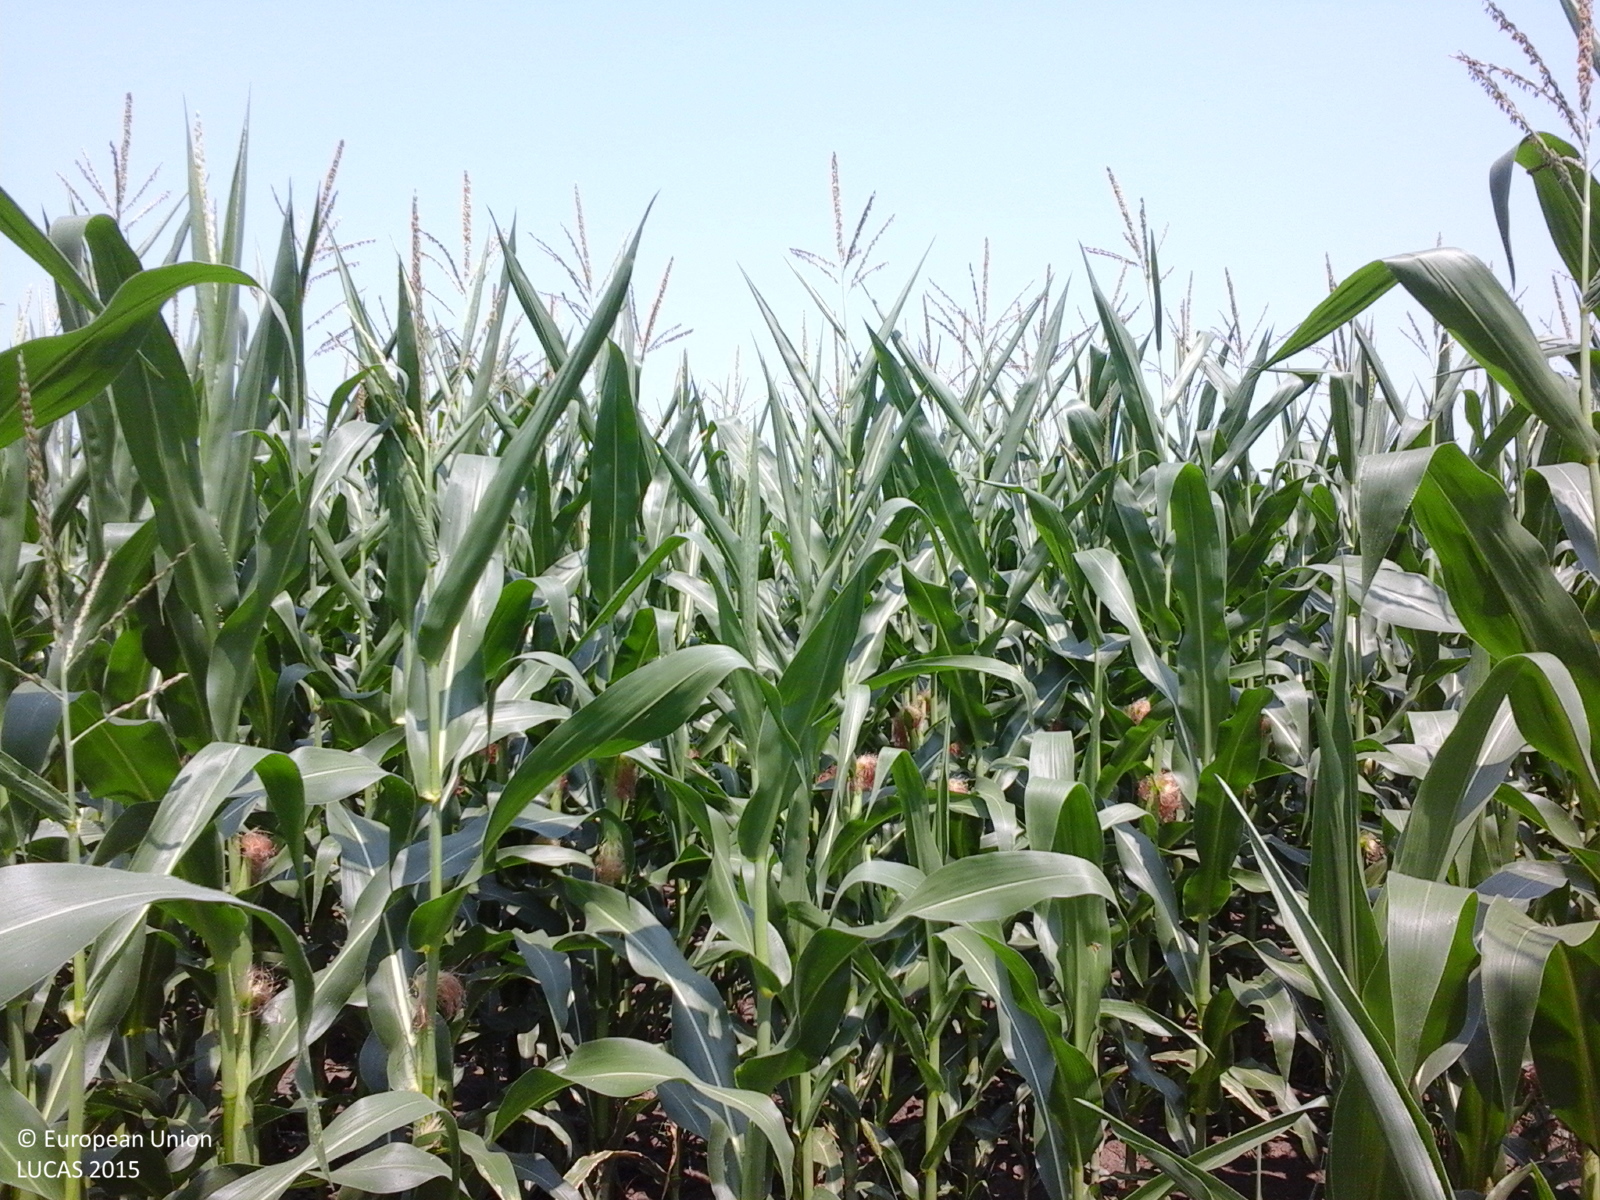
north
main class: Cropland
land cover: Maize
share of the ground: > 75 %
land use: Agriculture (excluding fallow land and kitchen gardens)
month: July
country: RO
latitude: 44.7640
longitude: 26.2717
